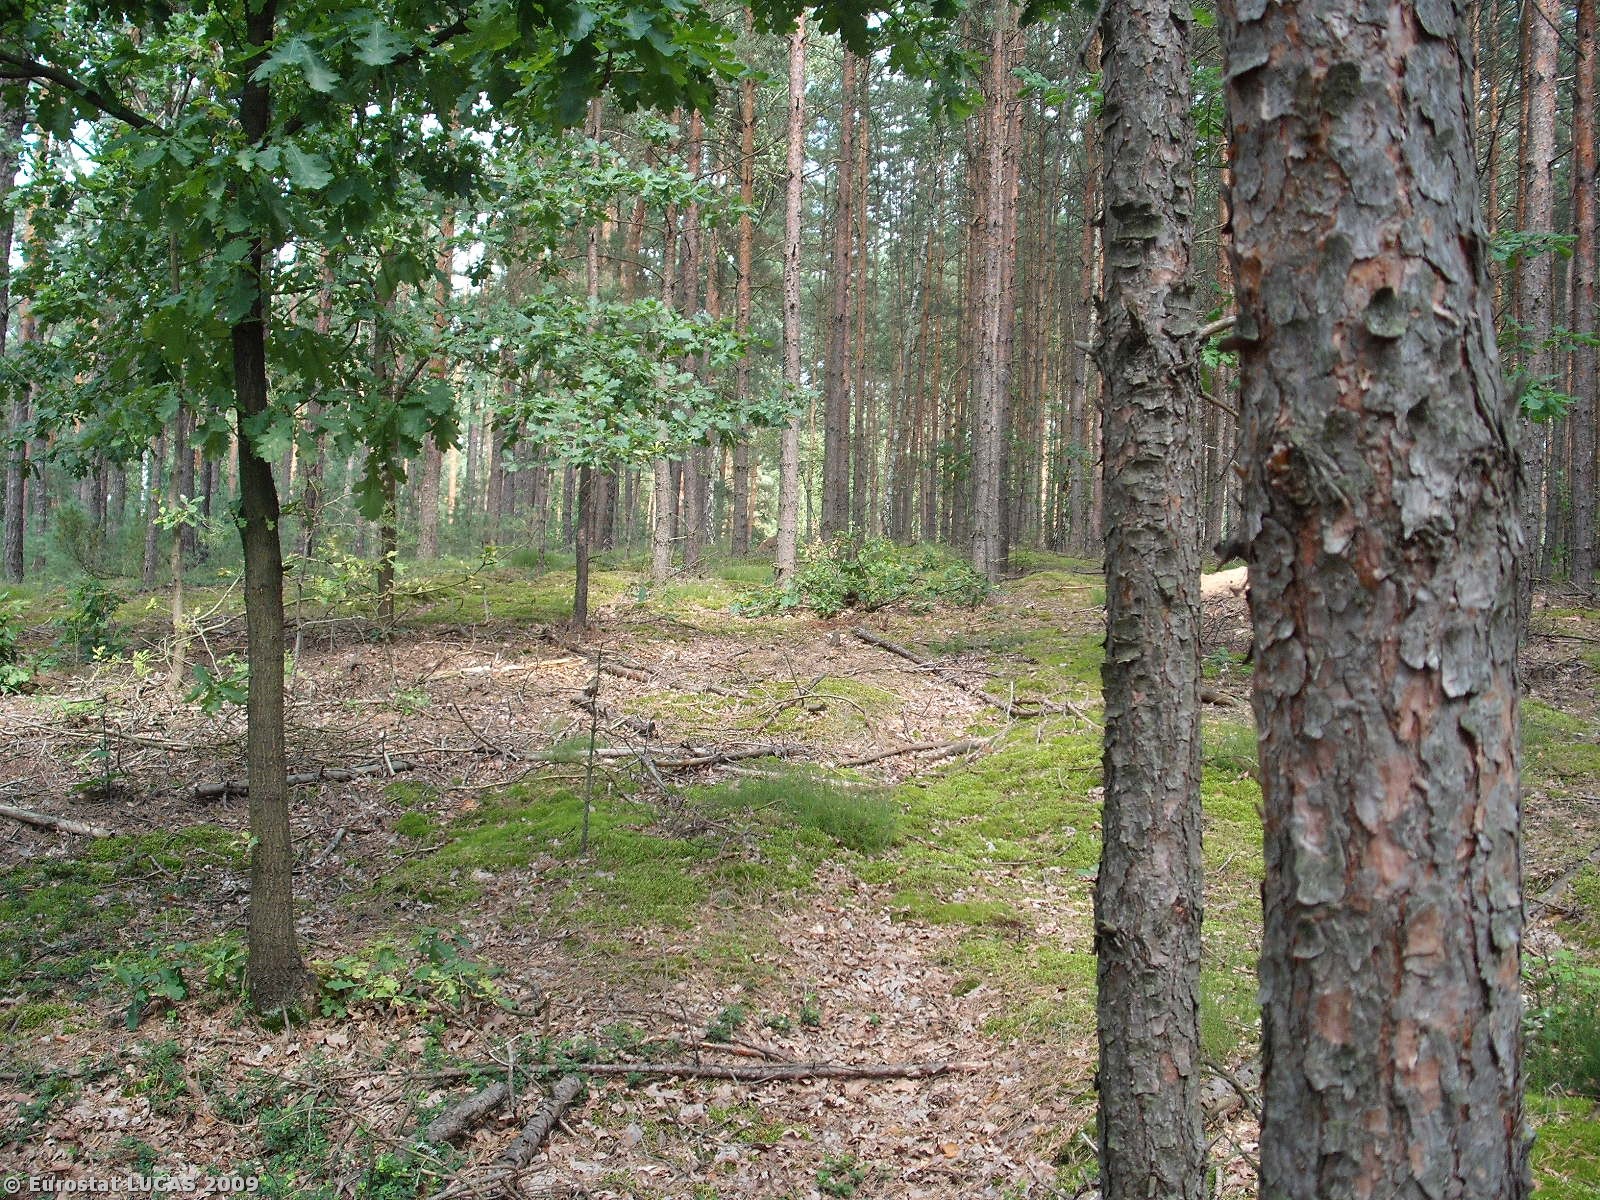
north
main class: Woodland
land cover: Coniferous woodland
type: hemiboreal forest and nemoral coniferous forest and mixed broadleaved-coniferous forest
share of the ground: > 75 %
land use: Forestry
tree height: > 5 m
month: August
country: PL
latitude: 51.7757
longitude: 21.5450
